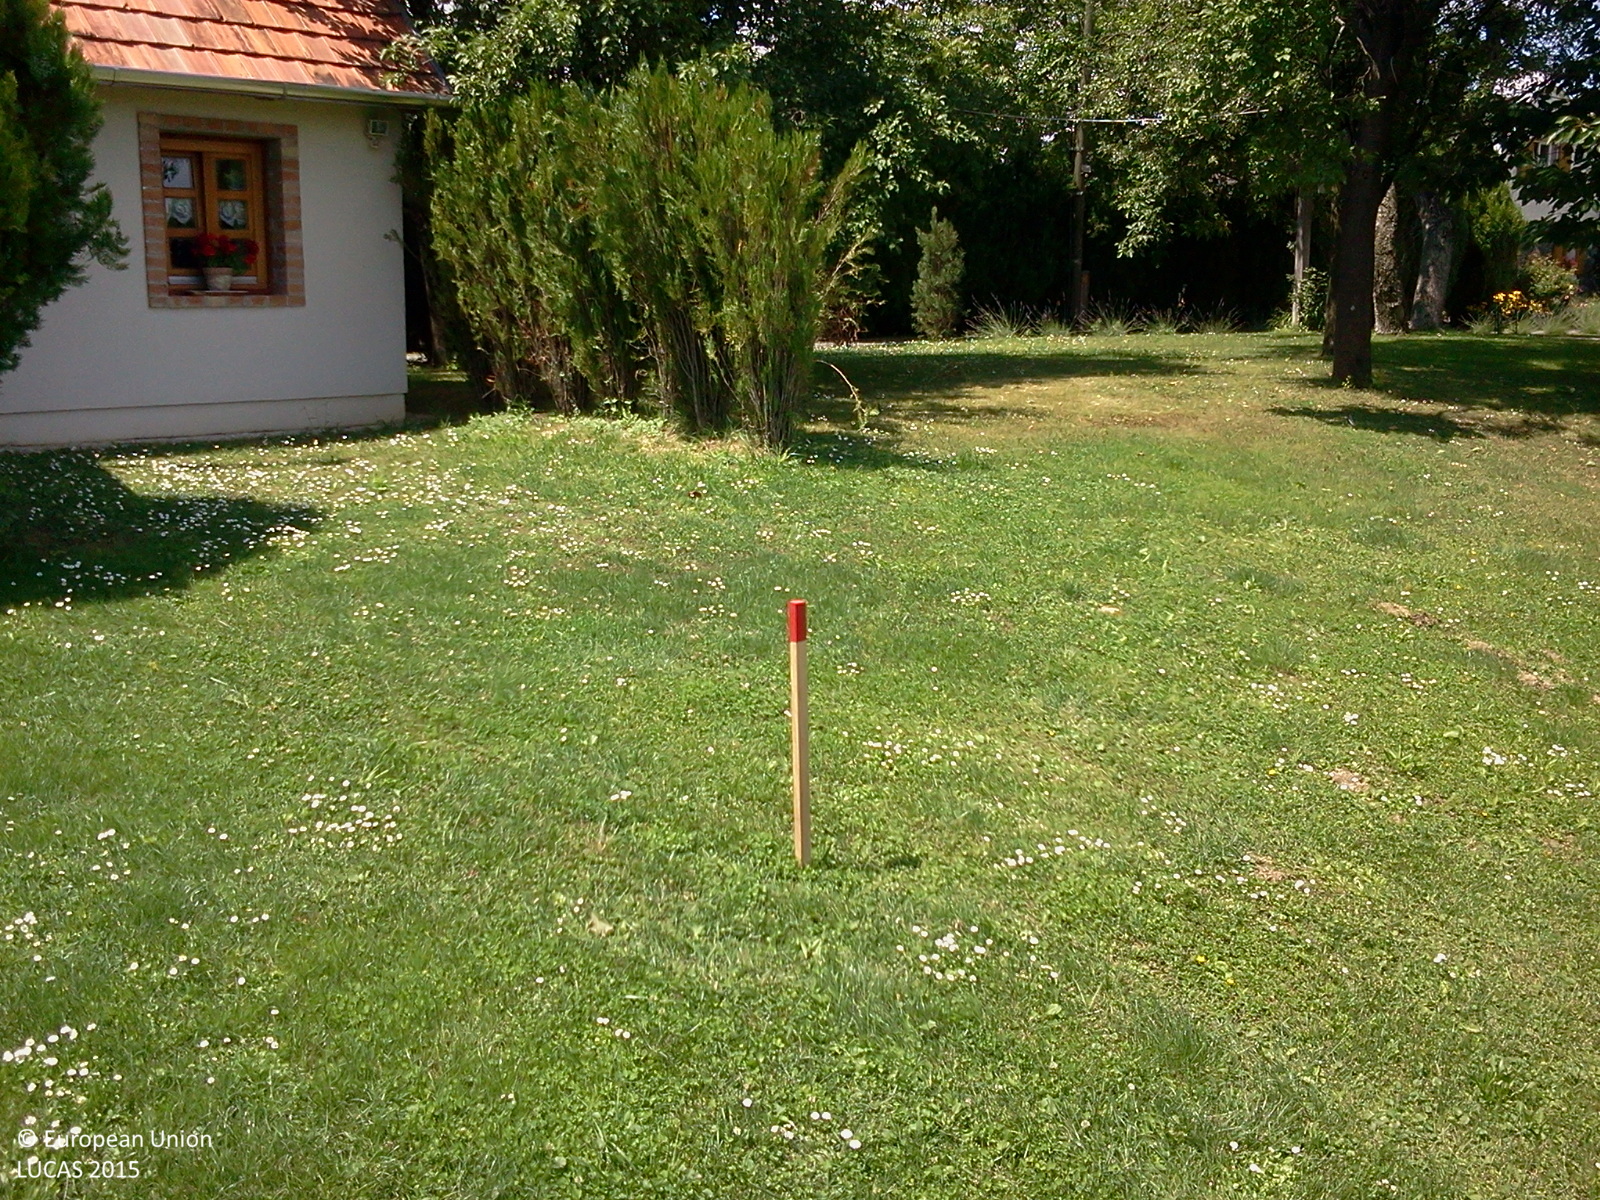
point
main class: Grassland
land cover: Grassland without tree/shrub cover
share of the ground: > 75 %
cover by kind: herbaceous plants 100 %
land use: Agriculture (excluding fallow land and kitchen gardens)
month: June
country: HU
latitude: 46.8903
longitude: 17.1311
